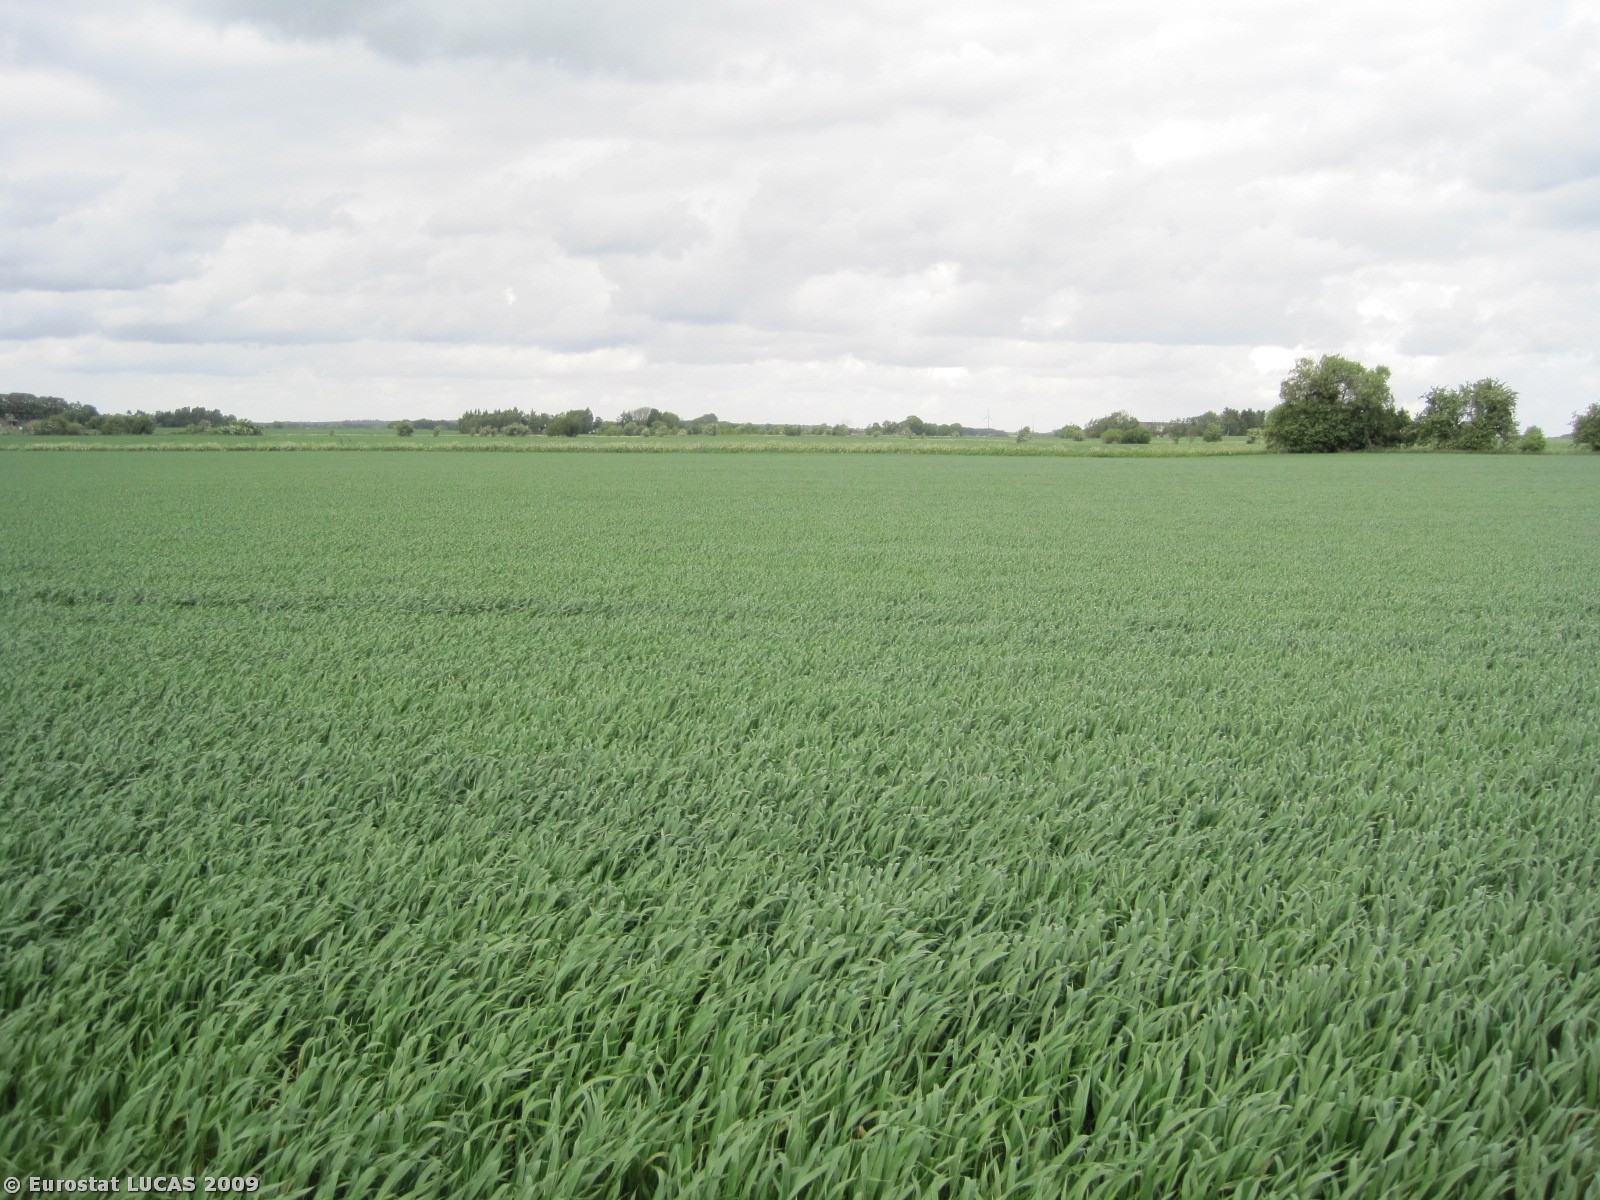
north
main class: Cropland
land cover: Oats
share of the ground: > 75 %
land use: Agriculture (excluding fallow land and kitchen gardens)
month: May
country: DK
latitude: 56.5113
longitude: 10.0487
